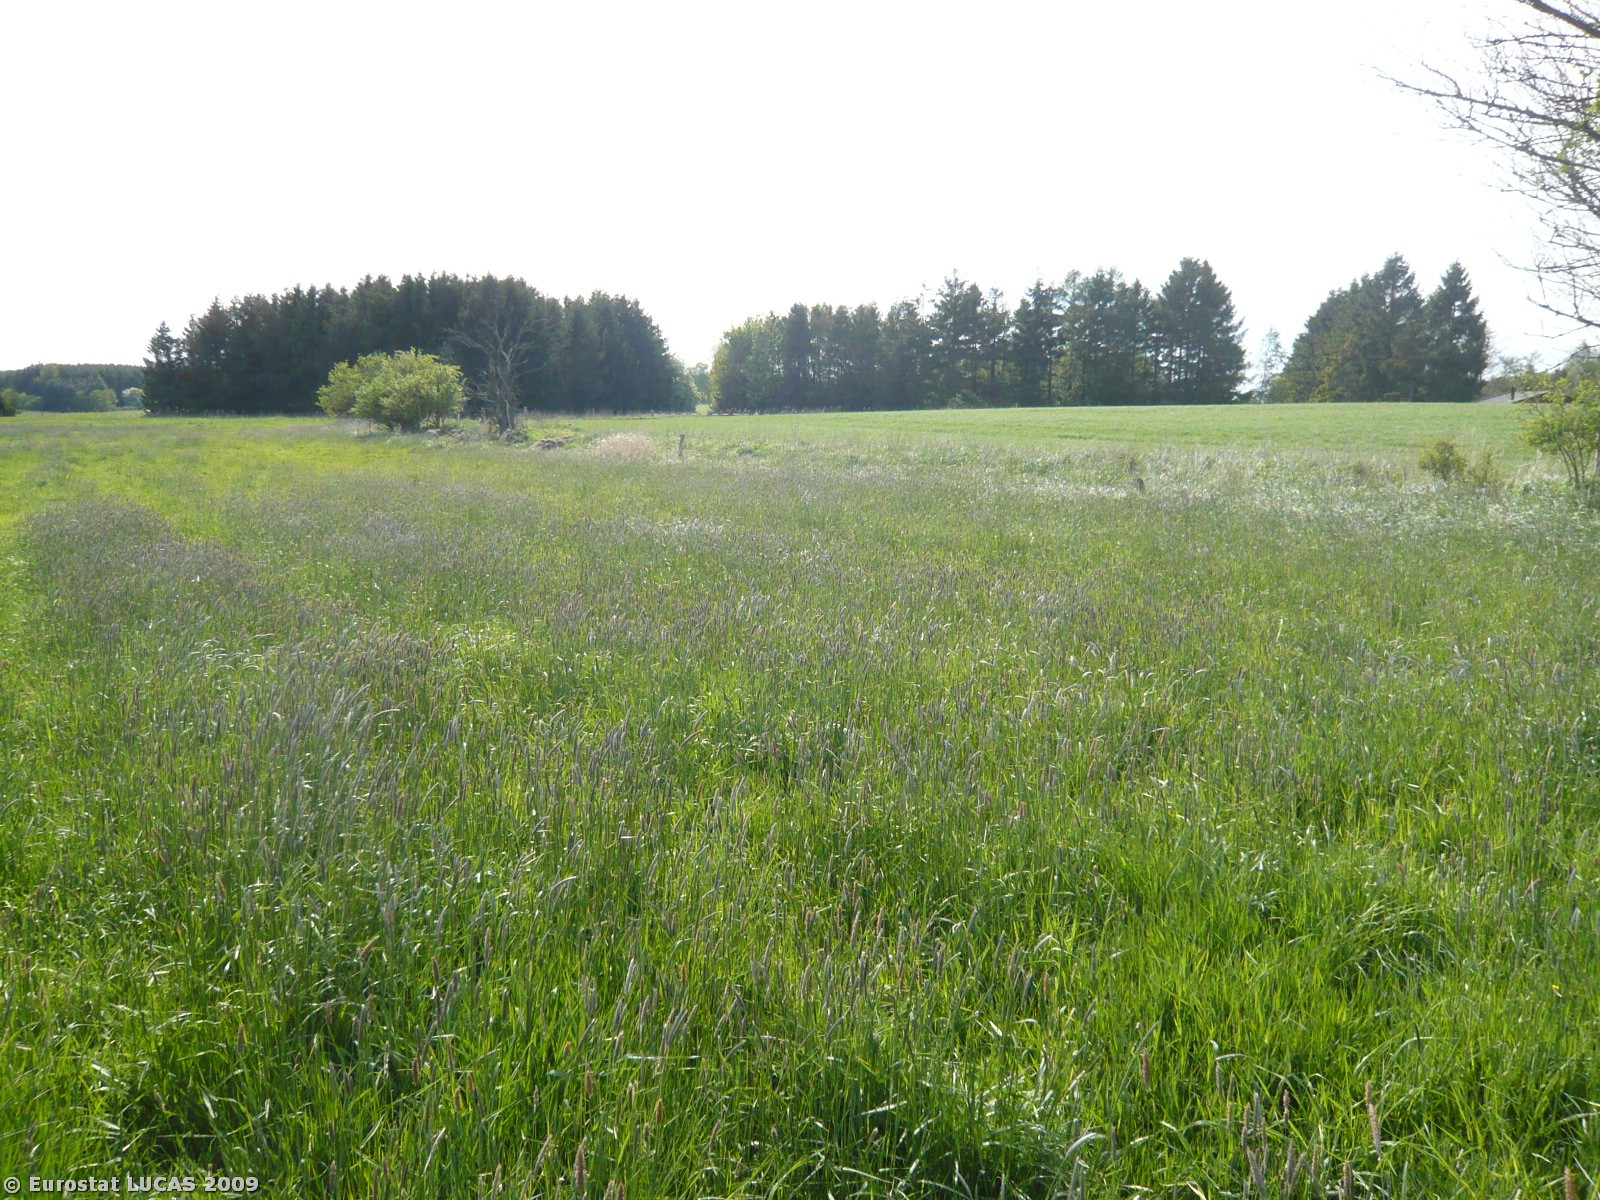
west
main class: Grassland
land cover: Grassland without tree/shrub cover
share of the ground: > 75 %
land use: Agriculture (excluding fallow land and kitchen gardens)
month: May
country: DK
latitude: 55.2732
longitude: 11.9975
